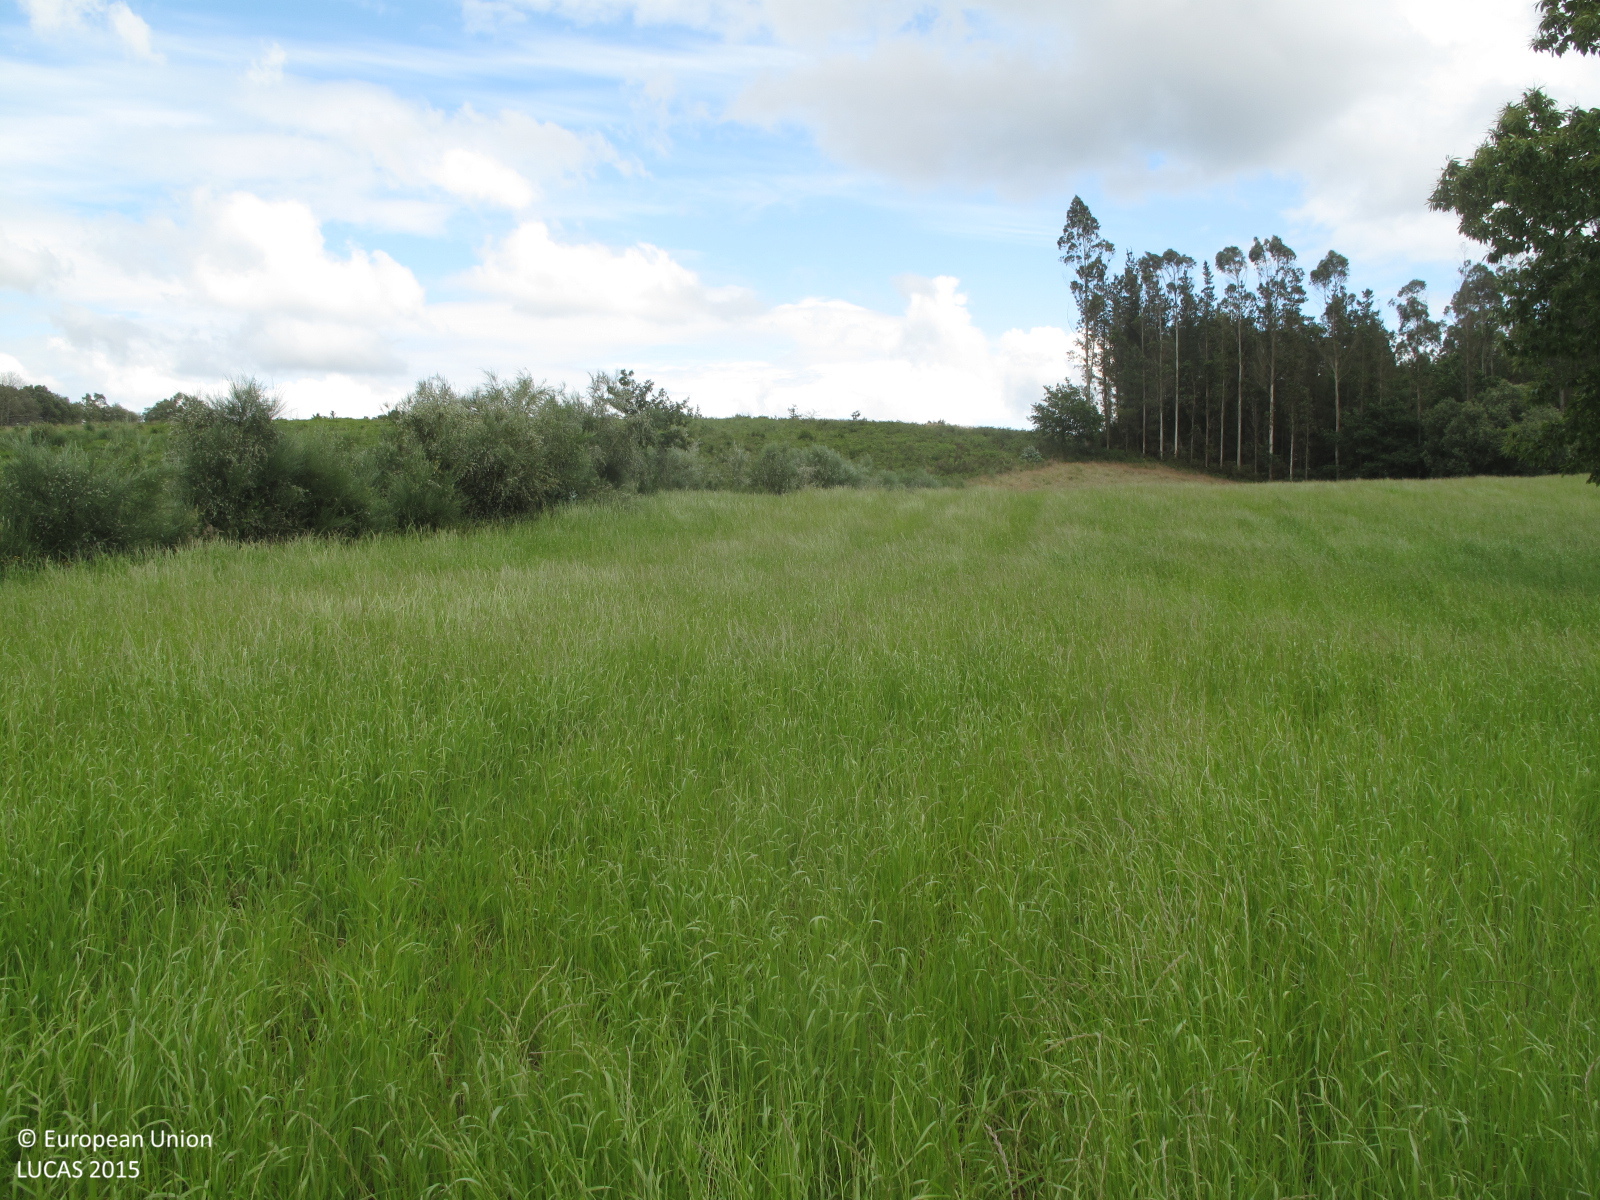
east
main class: Grassland
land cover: Grassland without tree/shrub cover
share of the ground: > 75 %
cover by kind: herbaceous plants 100 %
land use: Agriculture (excluding fallow land and kitchen gardens)
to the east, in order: Grassland without tree/shrub cover; Shrubland with sparse tree cover; Grassland with sparse tree/shrub cover
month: June
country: ES
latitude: 43.0202
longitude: -8.4991
